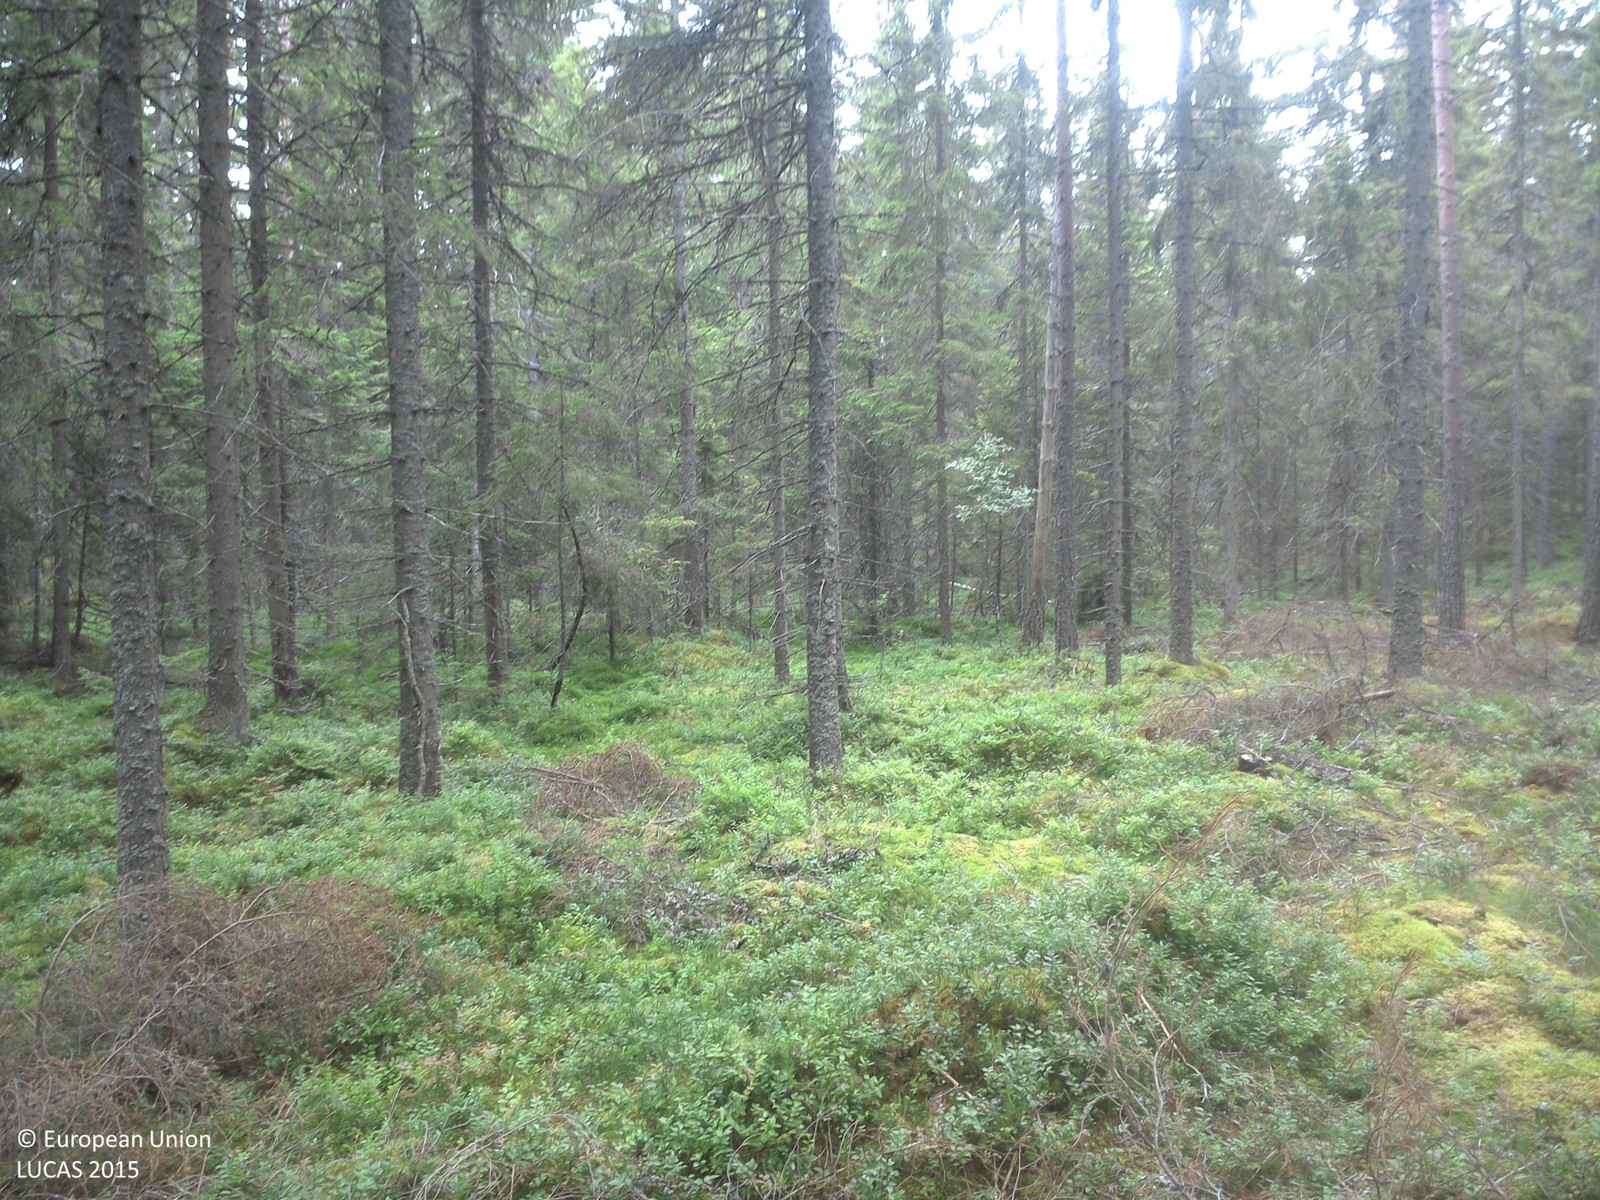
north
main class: Woodland
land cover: Spruce dominated coniferous woodland
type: boreal forest
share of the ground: 50 - 75 %
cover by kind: coniferous forest trees 65 %, lichens and mosses 25 %, herbaceous plants 10 %
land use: Forestry
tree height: > 5 m
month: August
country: SE
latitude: 57.7536
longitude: 15.3227
